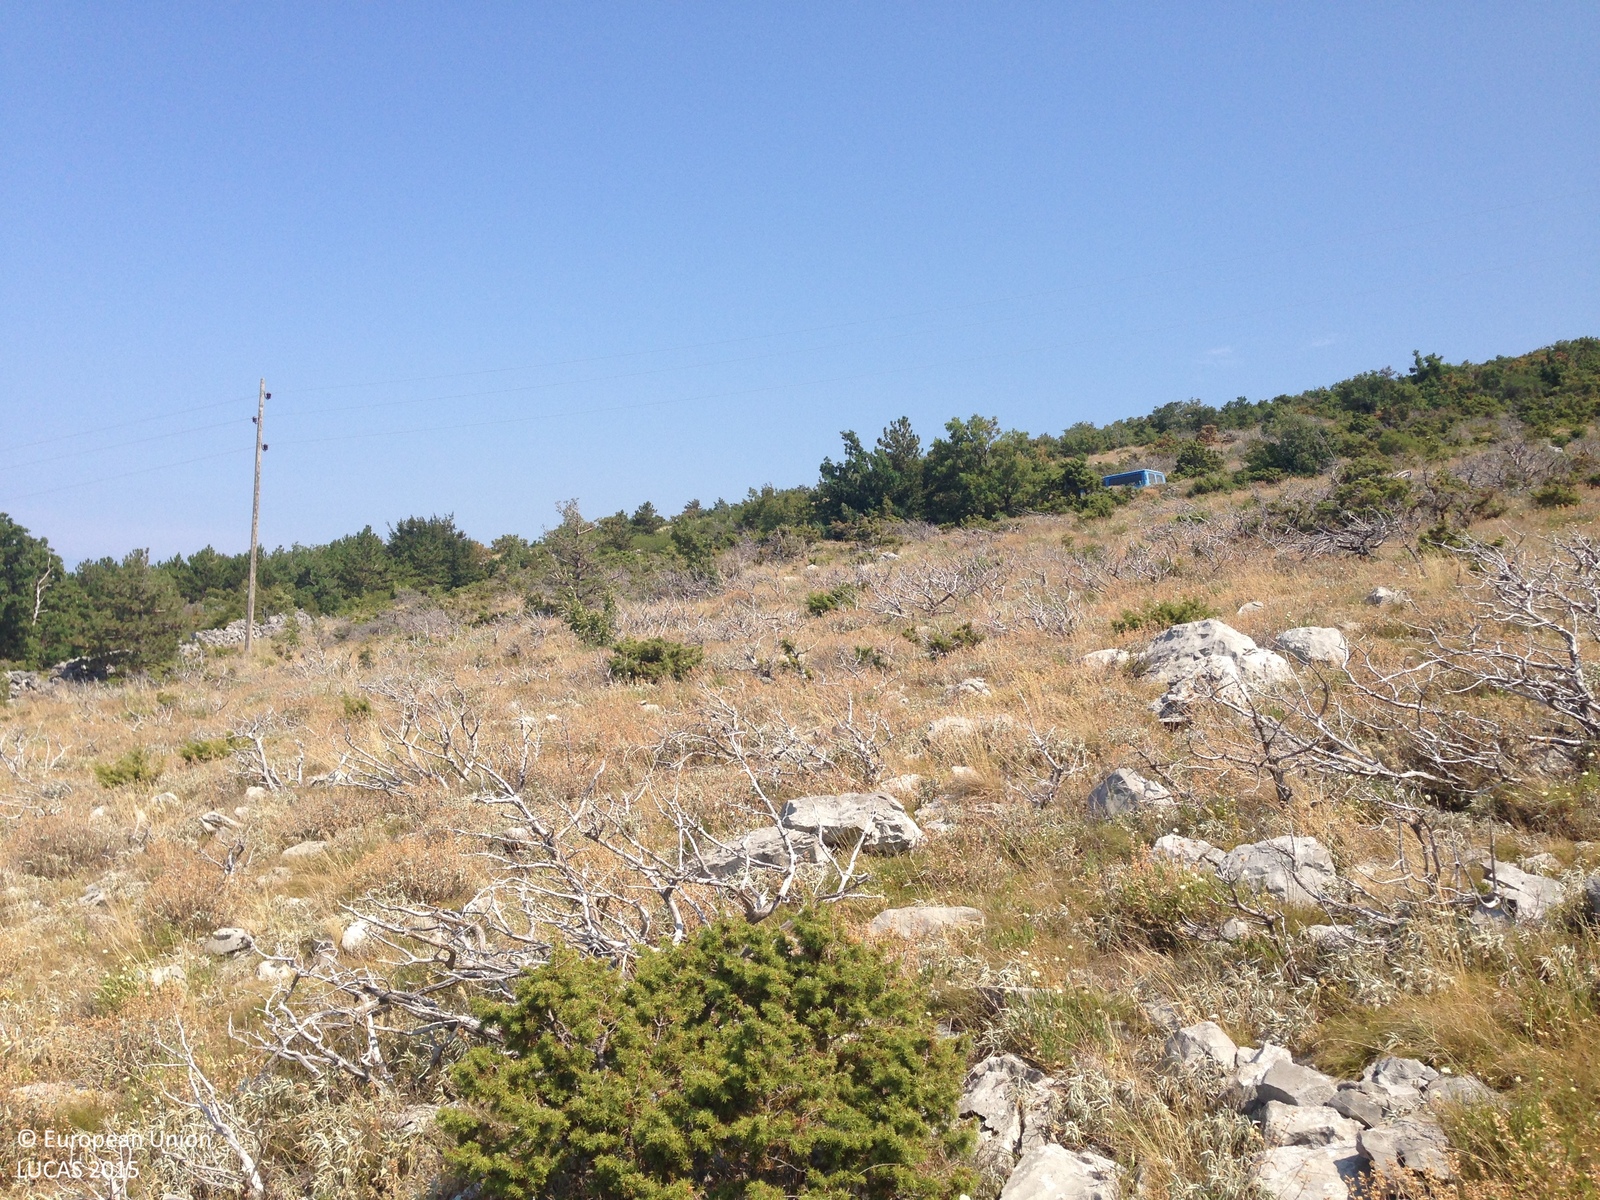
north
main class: Shrubland
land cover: Shrubland with sparse tree cover
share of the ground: 25 - 50 %
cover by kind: shrubs 40 %, herbaceous plants 25 %, unconsolidated bare surface 20 %, consolidated bare surface 10 %, broadleaved forest trees 5 %
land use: Semi-natural and natural areas not in use
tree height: < 5 m
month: July
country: HR
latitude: 44.9370
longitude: 14.9489
